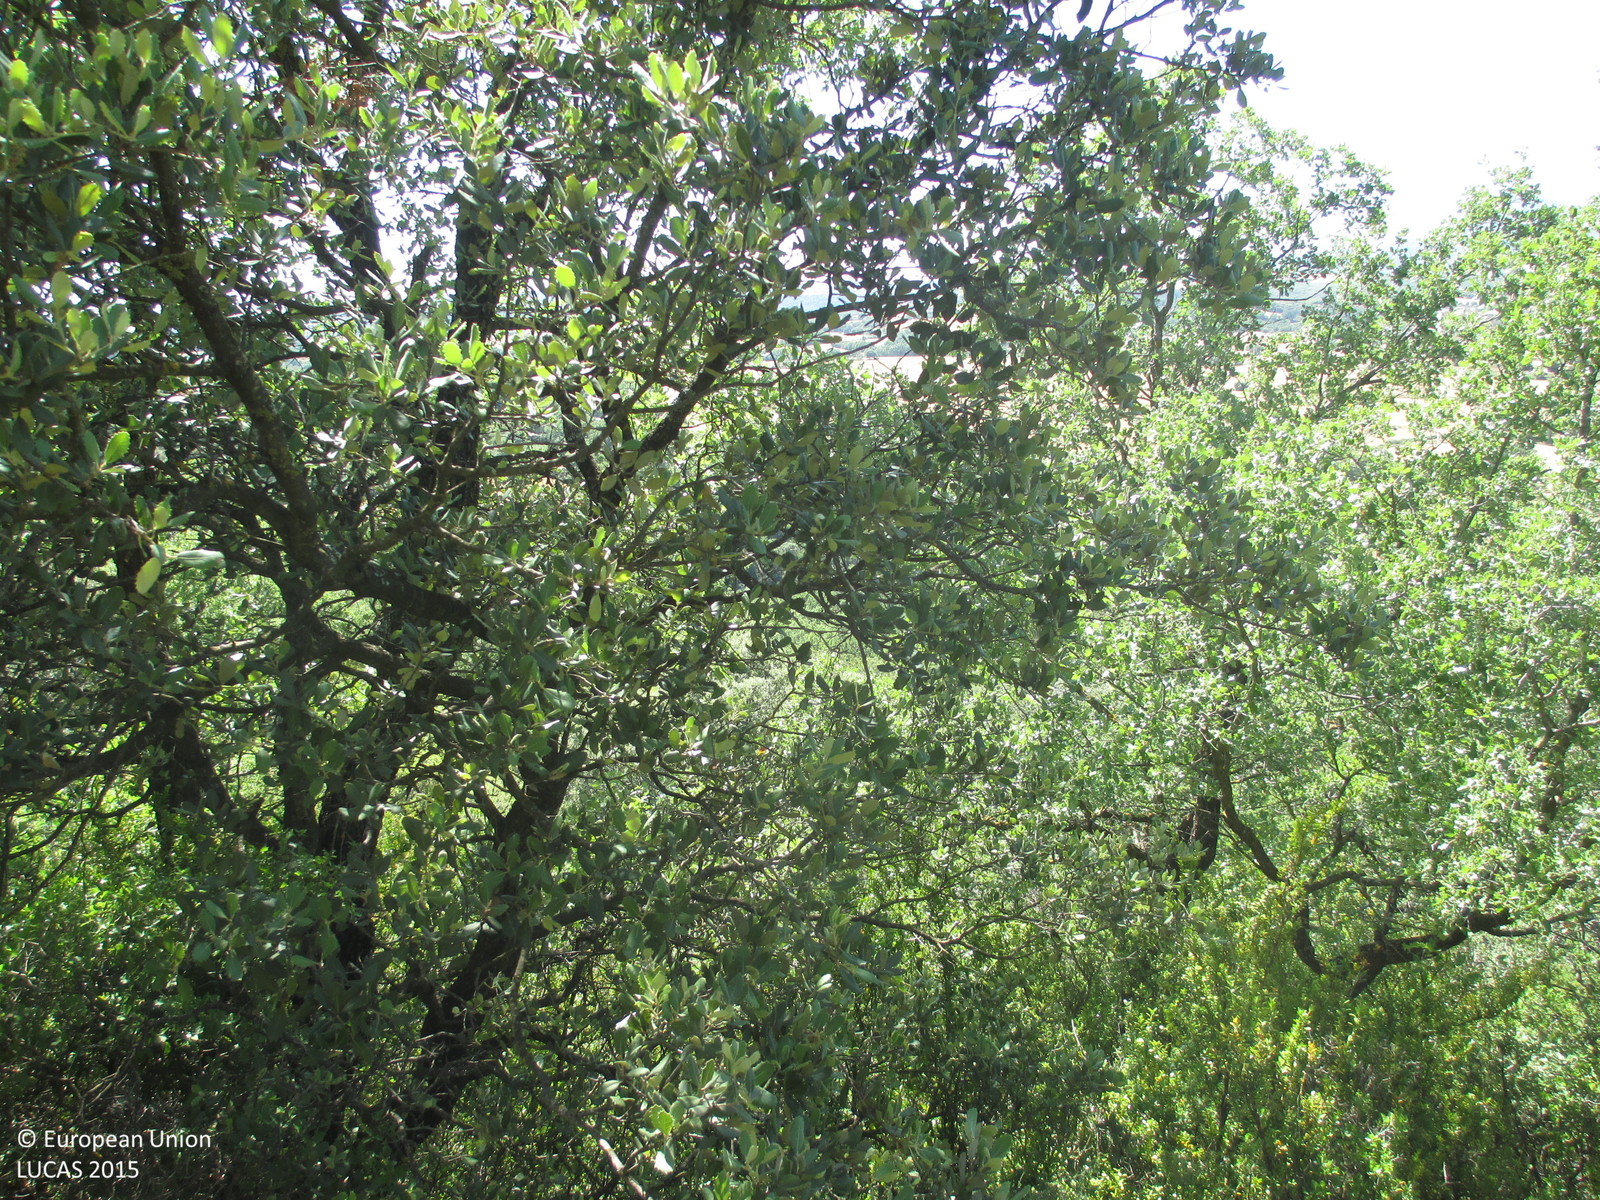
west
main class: Woodland
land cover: Broadleaved woodland
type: broadleaved evergreen forest
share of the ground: > 75 %
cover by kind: broadleaved forest trees 95 %, shrubs 5 %
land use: Semi-natural and natural areas not in use
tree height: < 5 m
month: June
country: ES
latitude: 42.1894
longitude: -0.2294
